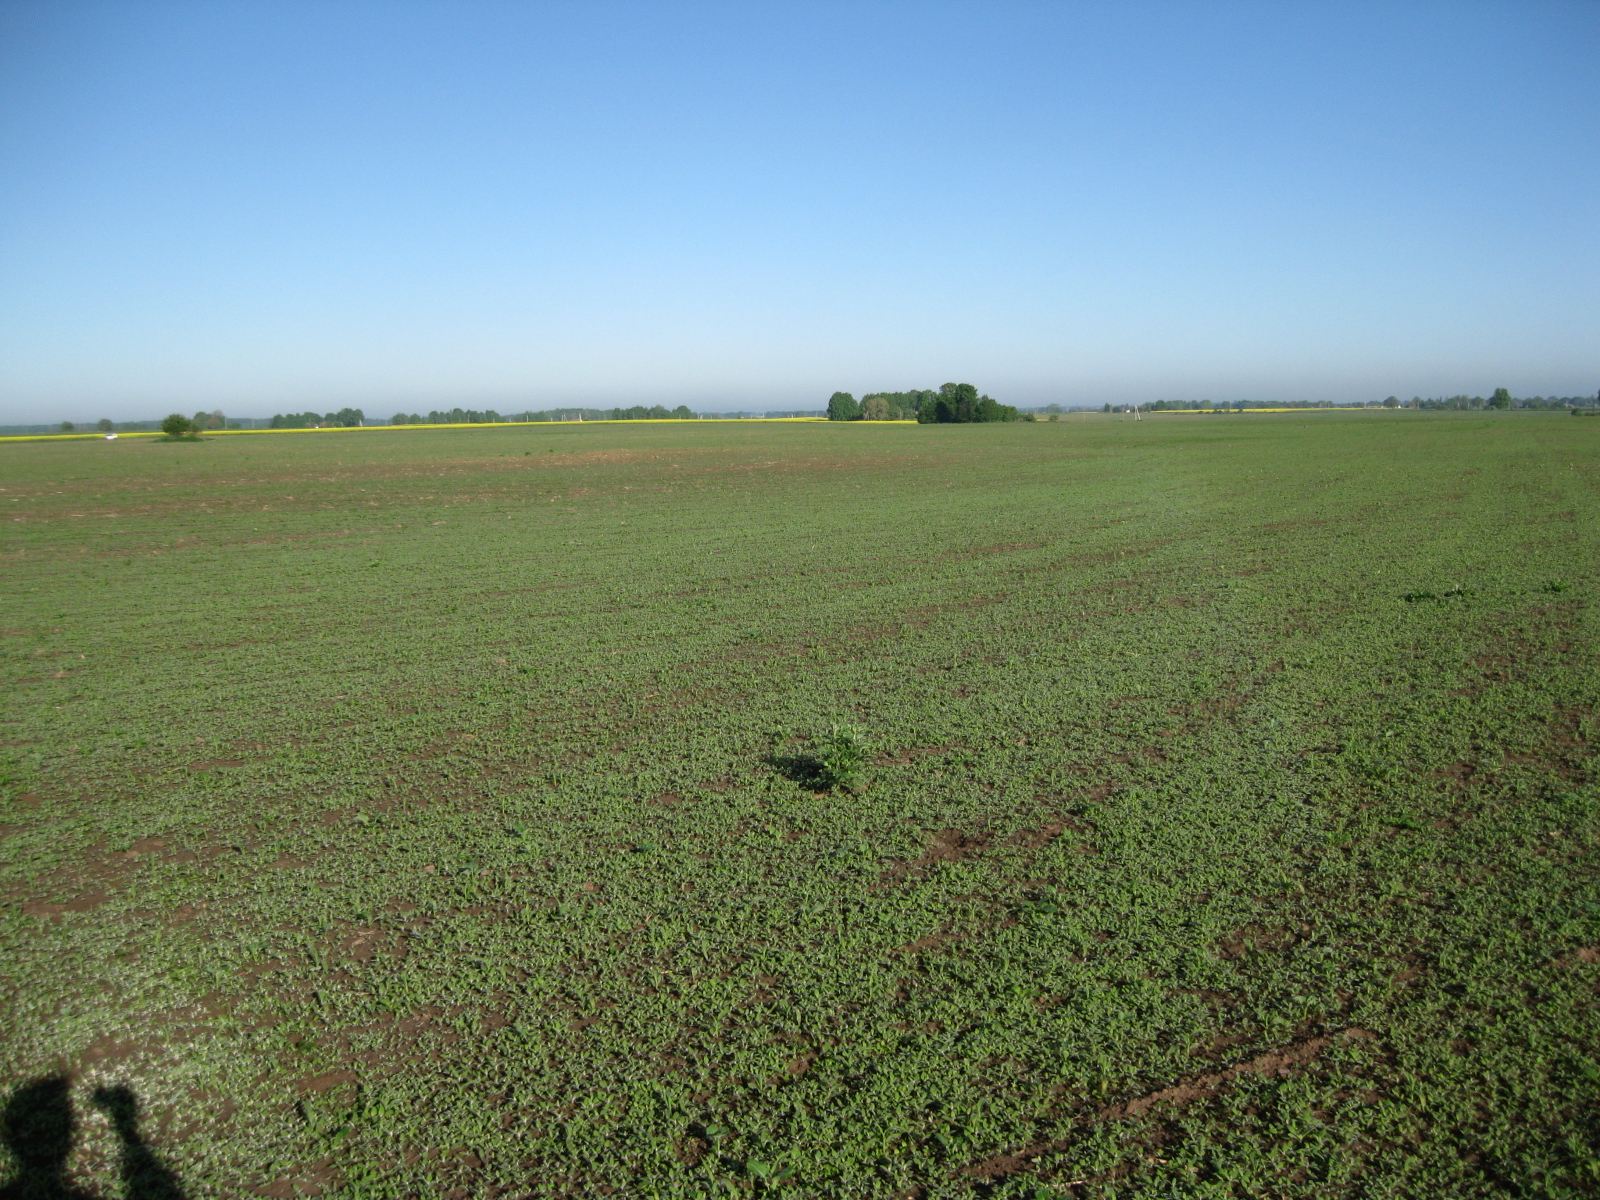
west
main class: Cropland
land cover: Maize
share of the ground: 25 - 50 %
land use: Agriculture (excluding fallow land and kitchen gardens)
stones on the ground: < 10 %
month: May
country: LT
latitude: 56.1659
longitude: 24.4777
